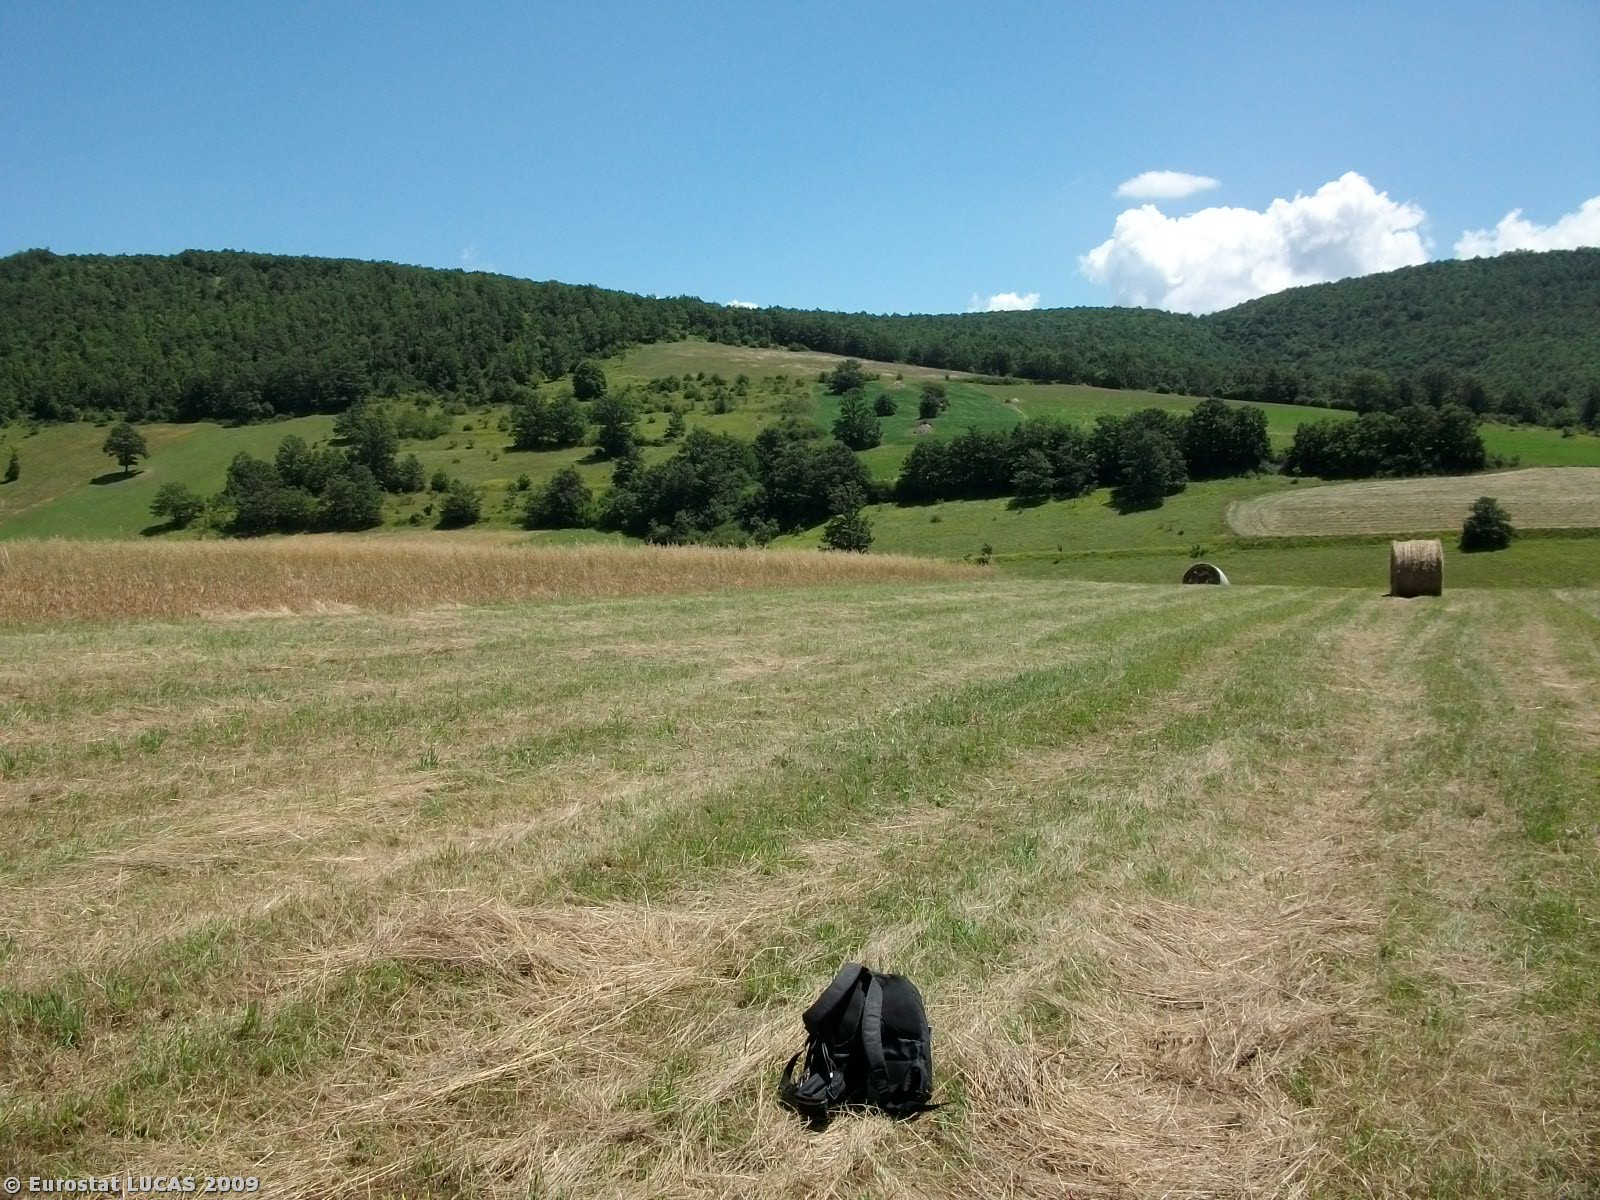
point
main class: Cropland
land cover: Temporary grasslands
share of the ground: > 75 %
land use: Agriculture (excluding fallow land and kitchen gardens)
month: July
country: IT
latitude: 43.0649
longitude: 12.8775
